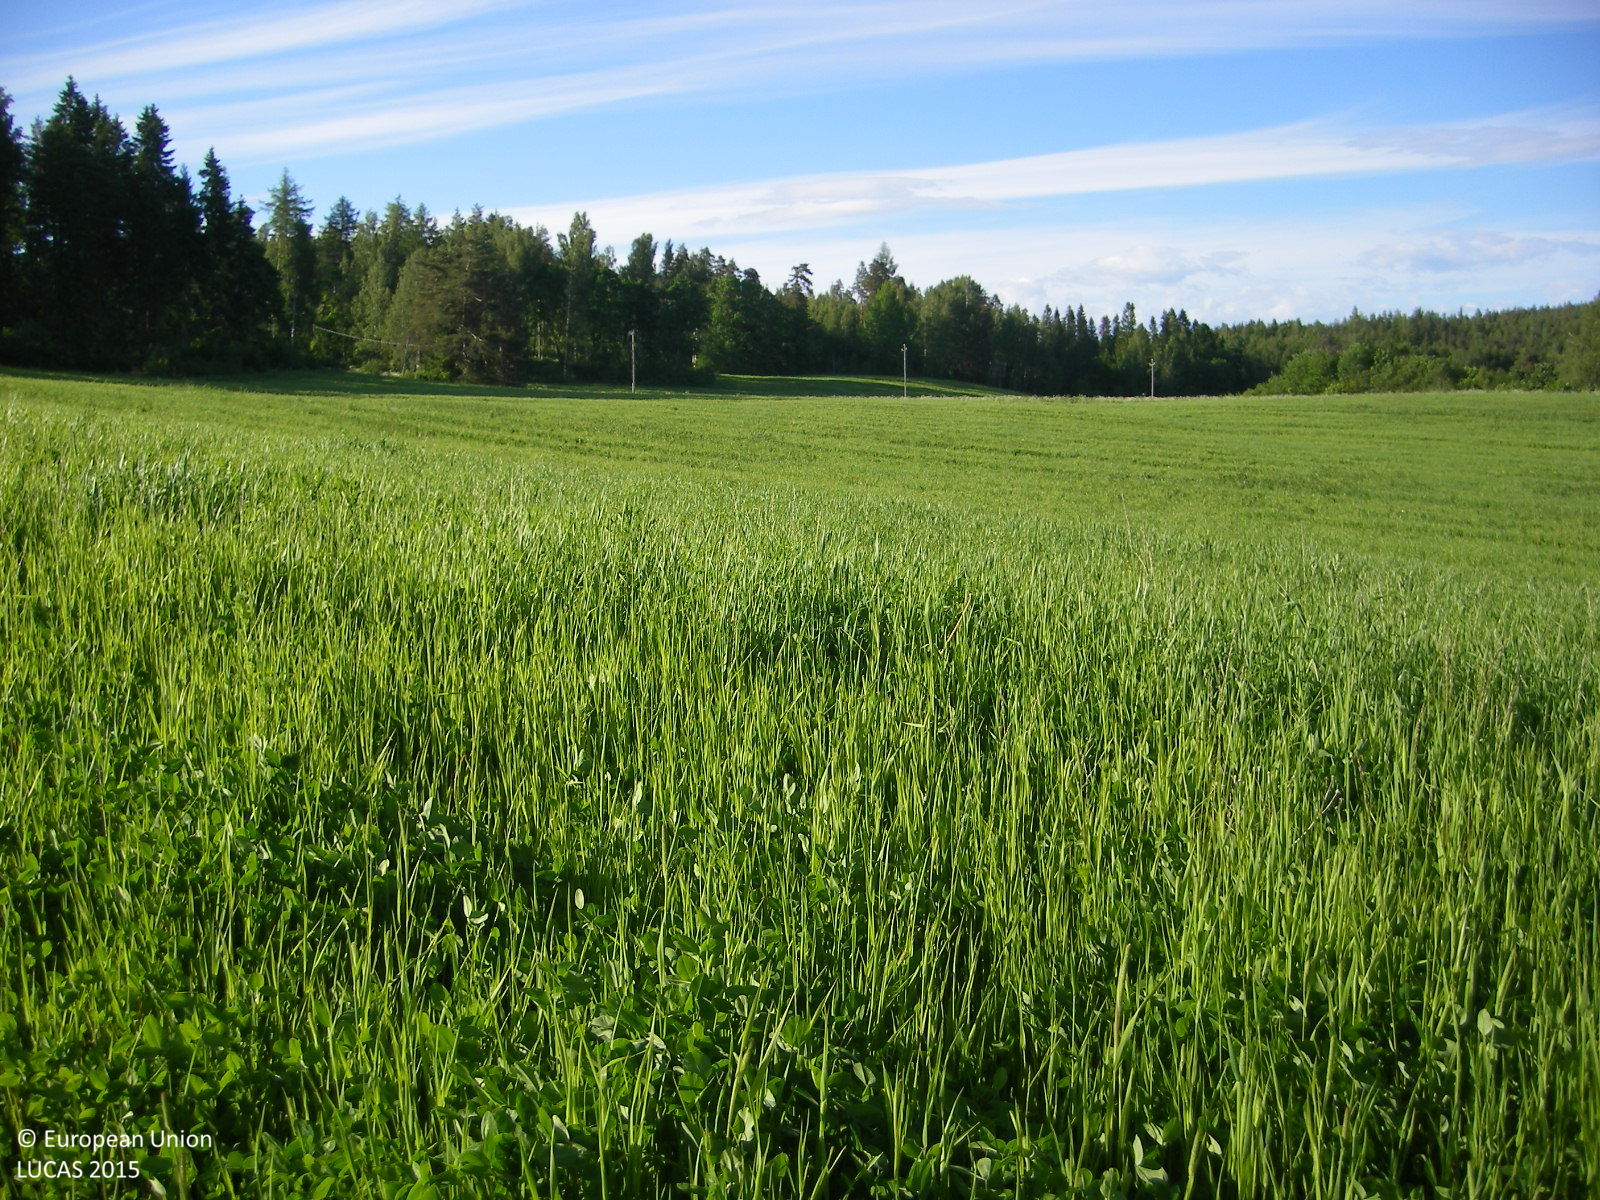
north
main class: Cropland
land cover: Other leguminous and mixtures for fodder
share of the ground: > 75 %
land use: Agriculture (excluding fallow land and kitchen gardens)
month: June
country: FI
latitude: 60.2941
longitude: 23.8990
